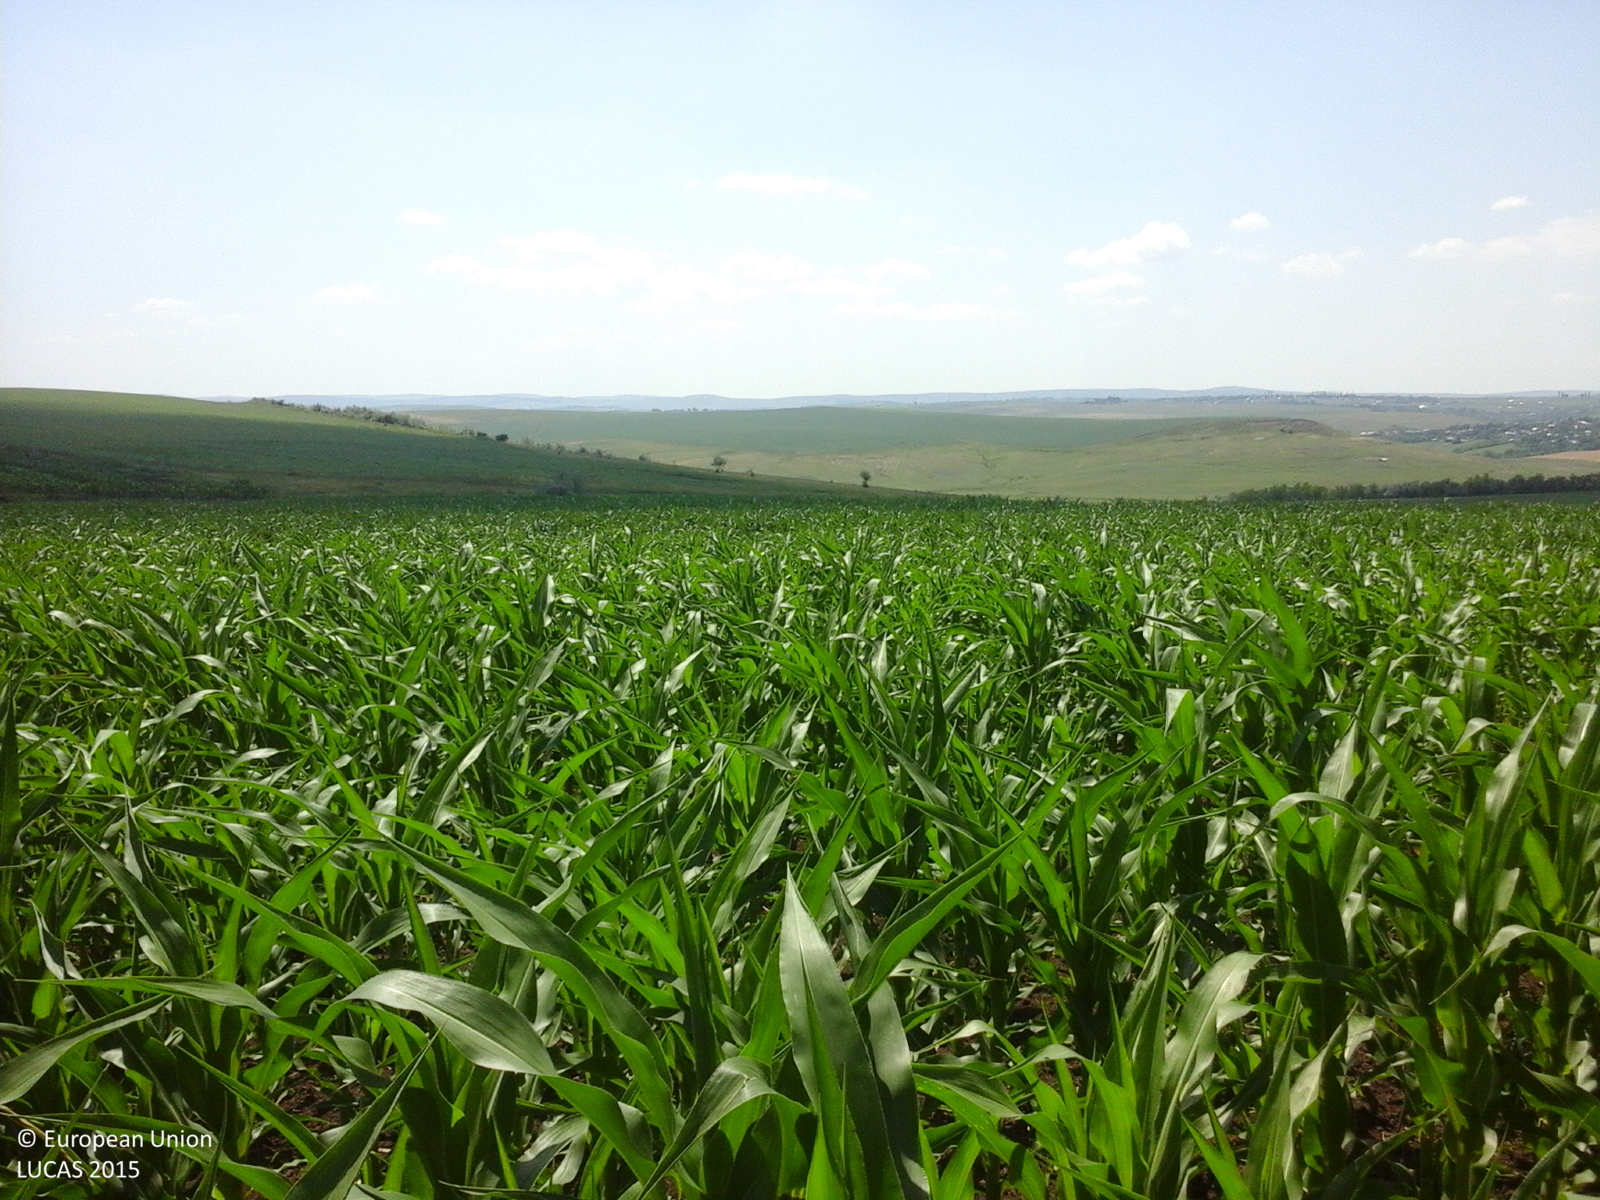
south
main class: Cropland
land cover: Maize
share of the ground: > 75 %
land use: Agriculture (excluding fallow land and kitchen gardens)
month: June
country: RO
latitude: 47.2069
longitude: 27.2038
